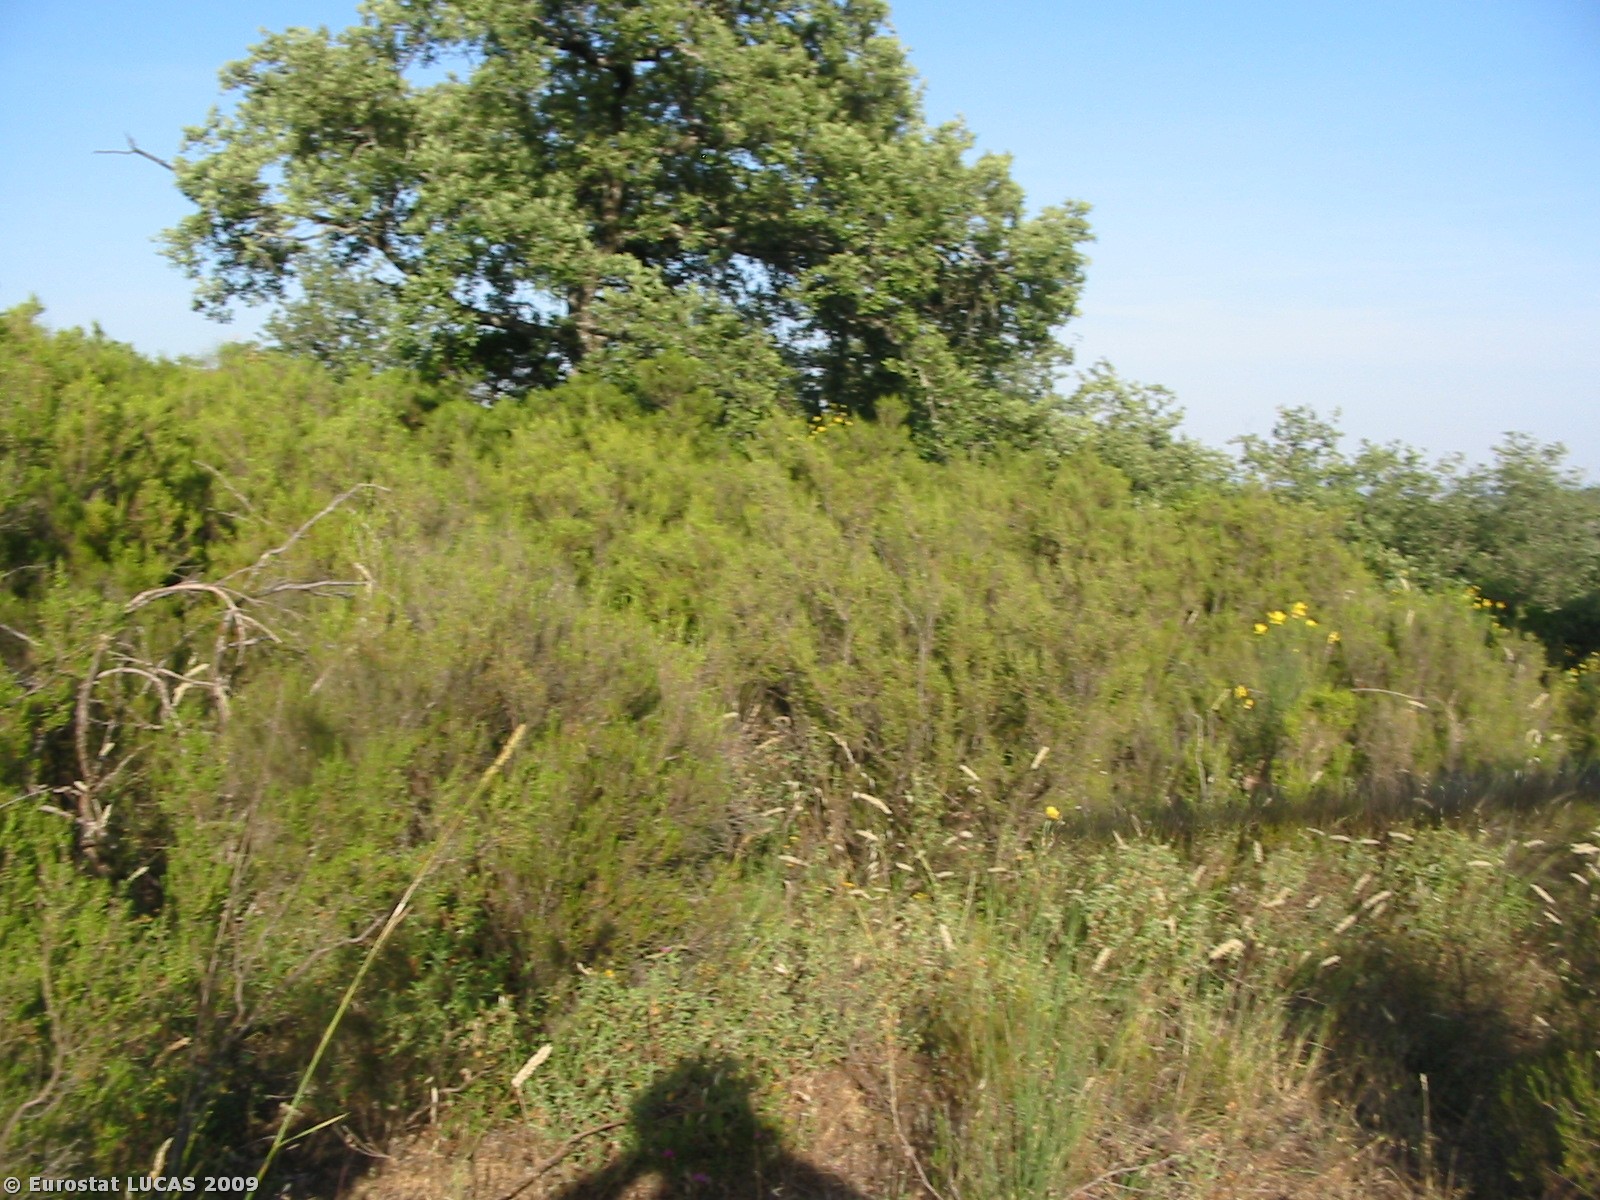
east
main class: Shrubland
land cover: Shrubland with sparse tree cover
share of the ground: > 75 %
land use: Unused
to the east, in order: Shrubland with sparse tree cover; Mixed woodland
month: June
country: IT
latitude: 43.2721
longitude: 11.6831
